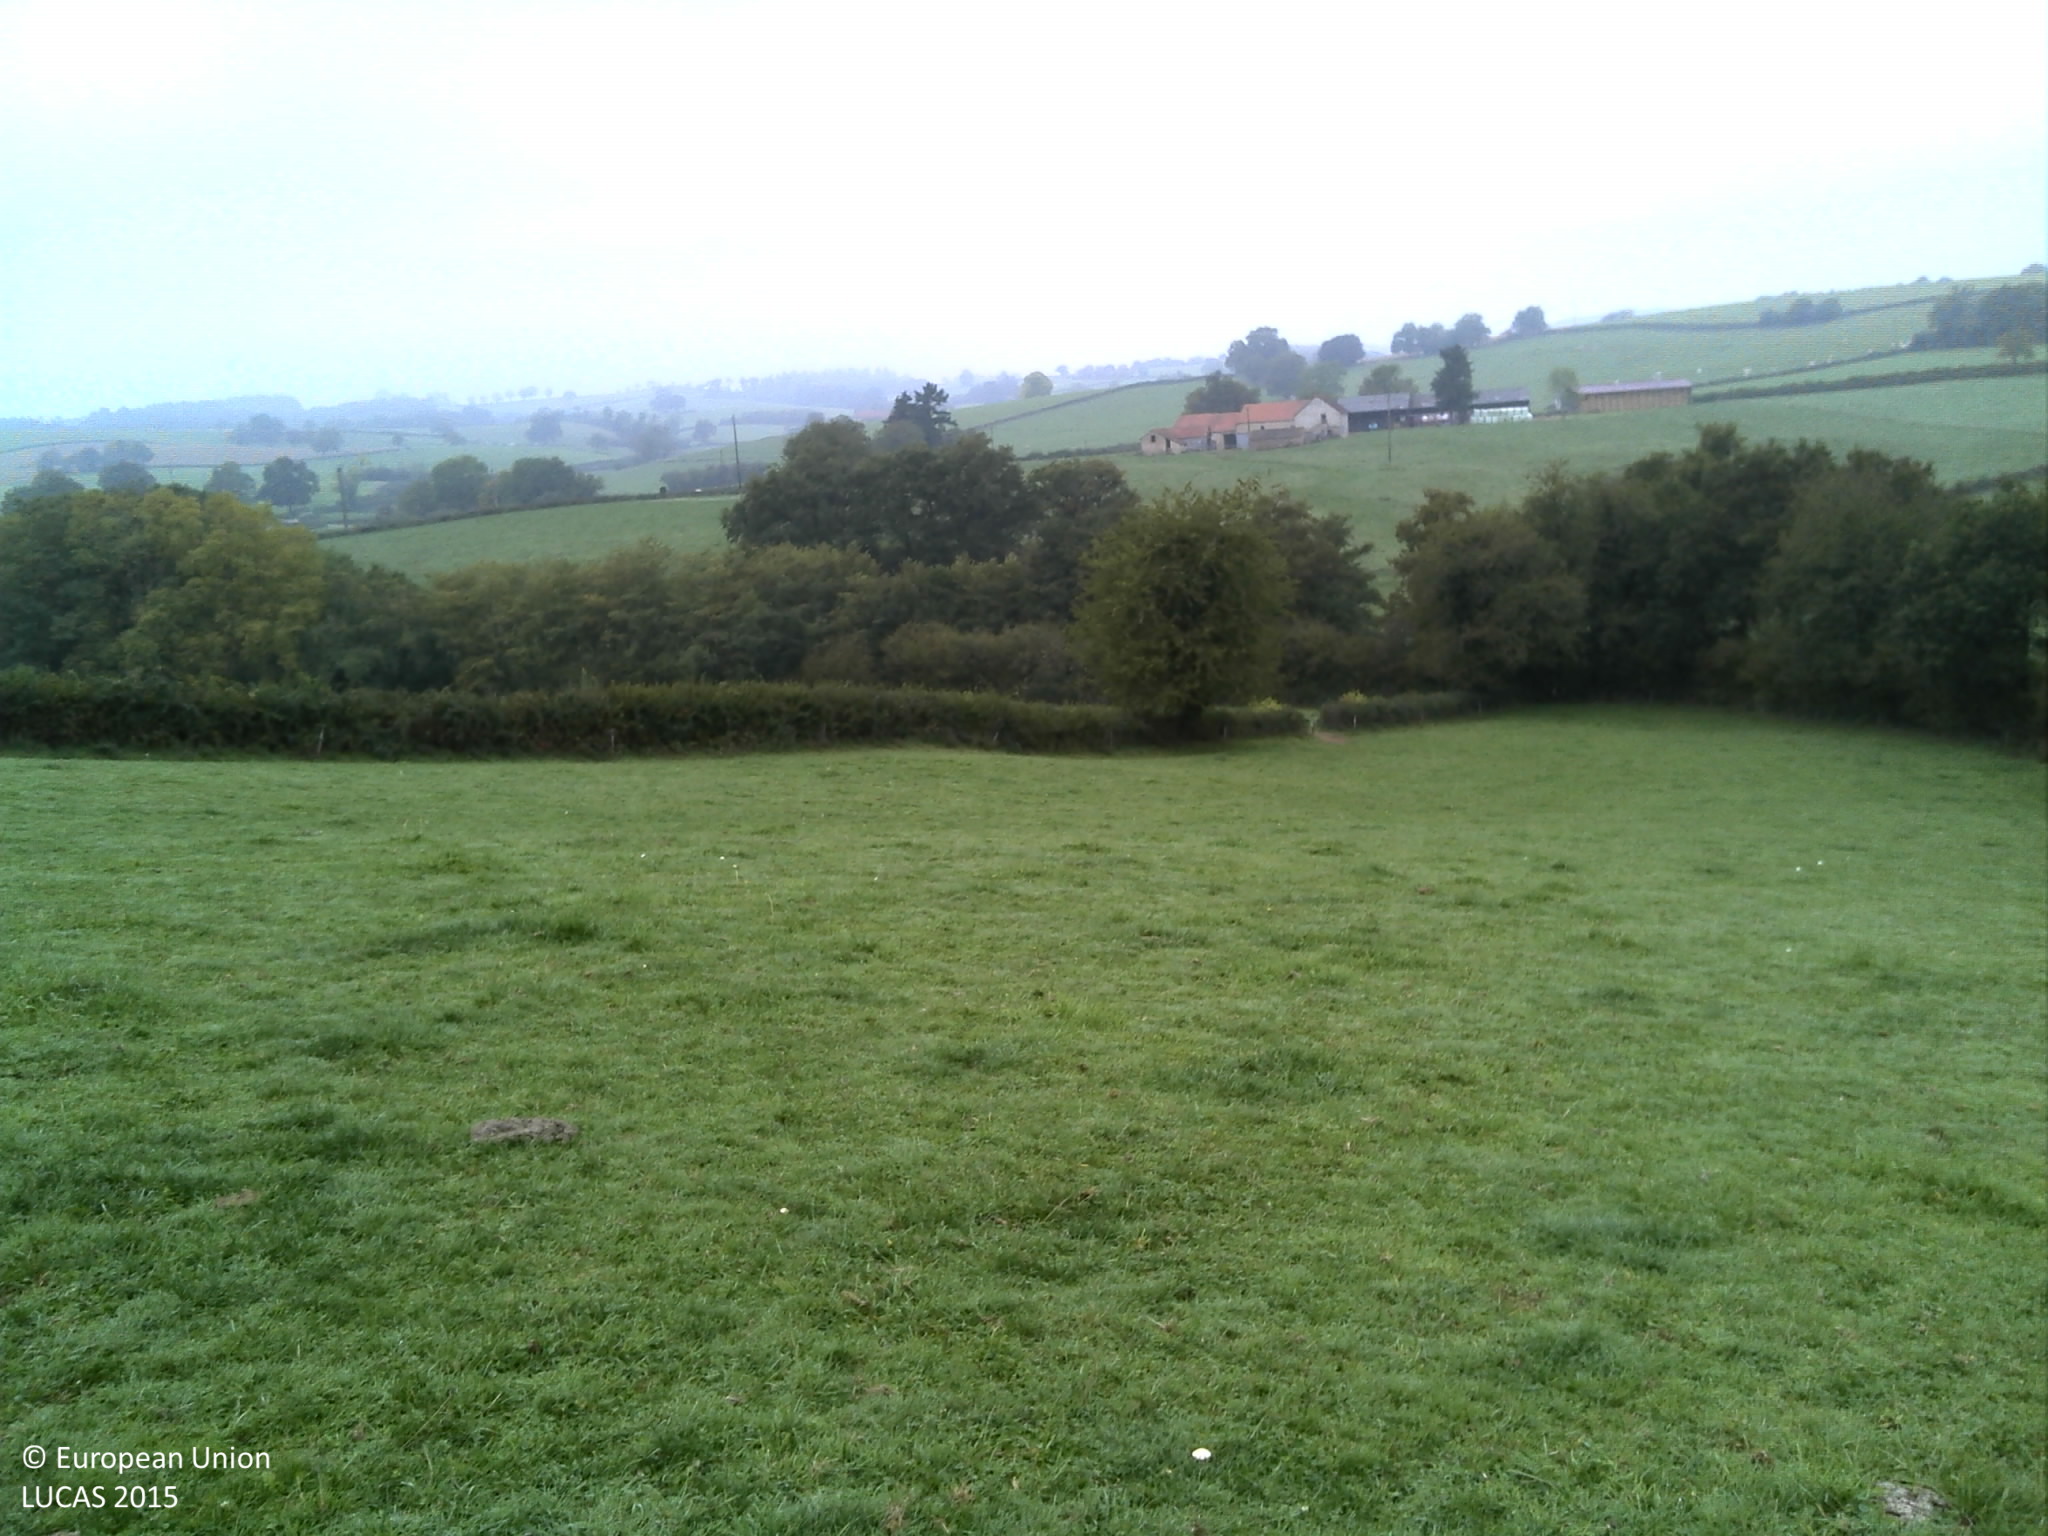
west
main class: Grassland
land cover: Grassland without tree/shrub cover
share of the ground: > 75 %
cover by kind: herbaceous plants 100 %
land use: Agriculture (excluding fallow land and kitchen gardens)
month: October
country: FR
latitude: 46.6868
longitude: 3.9721
